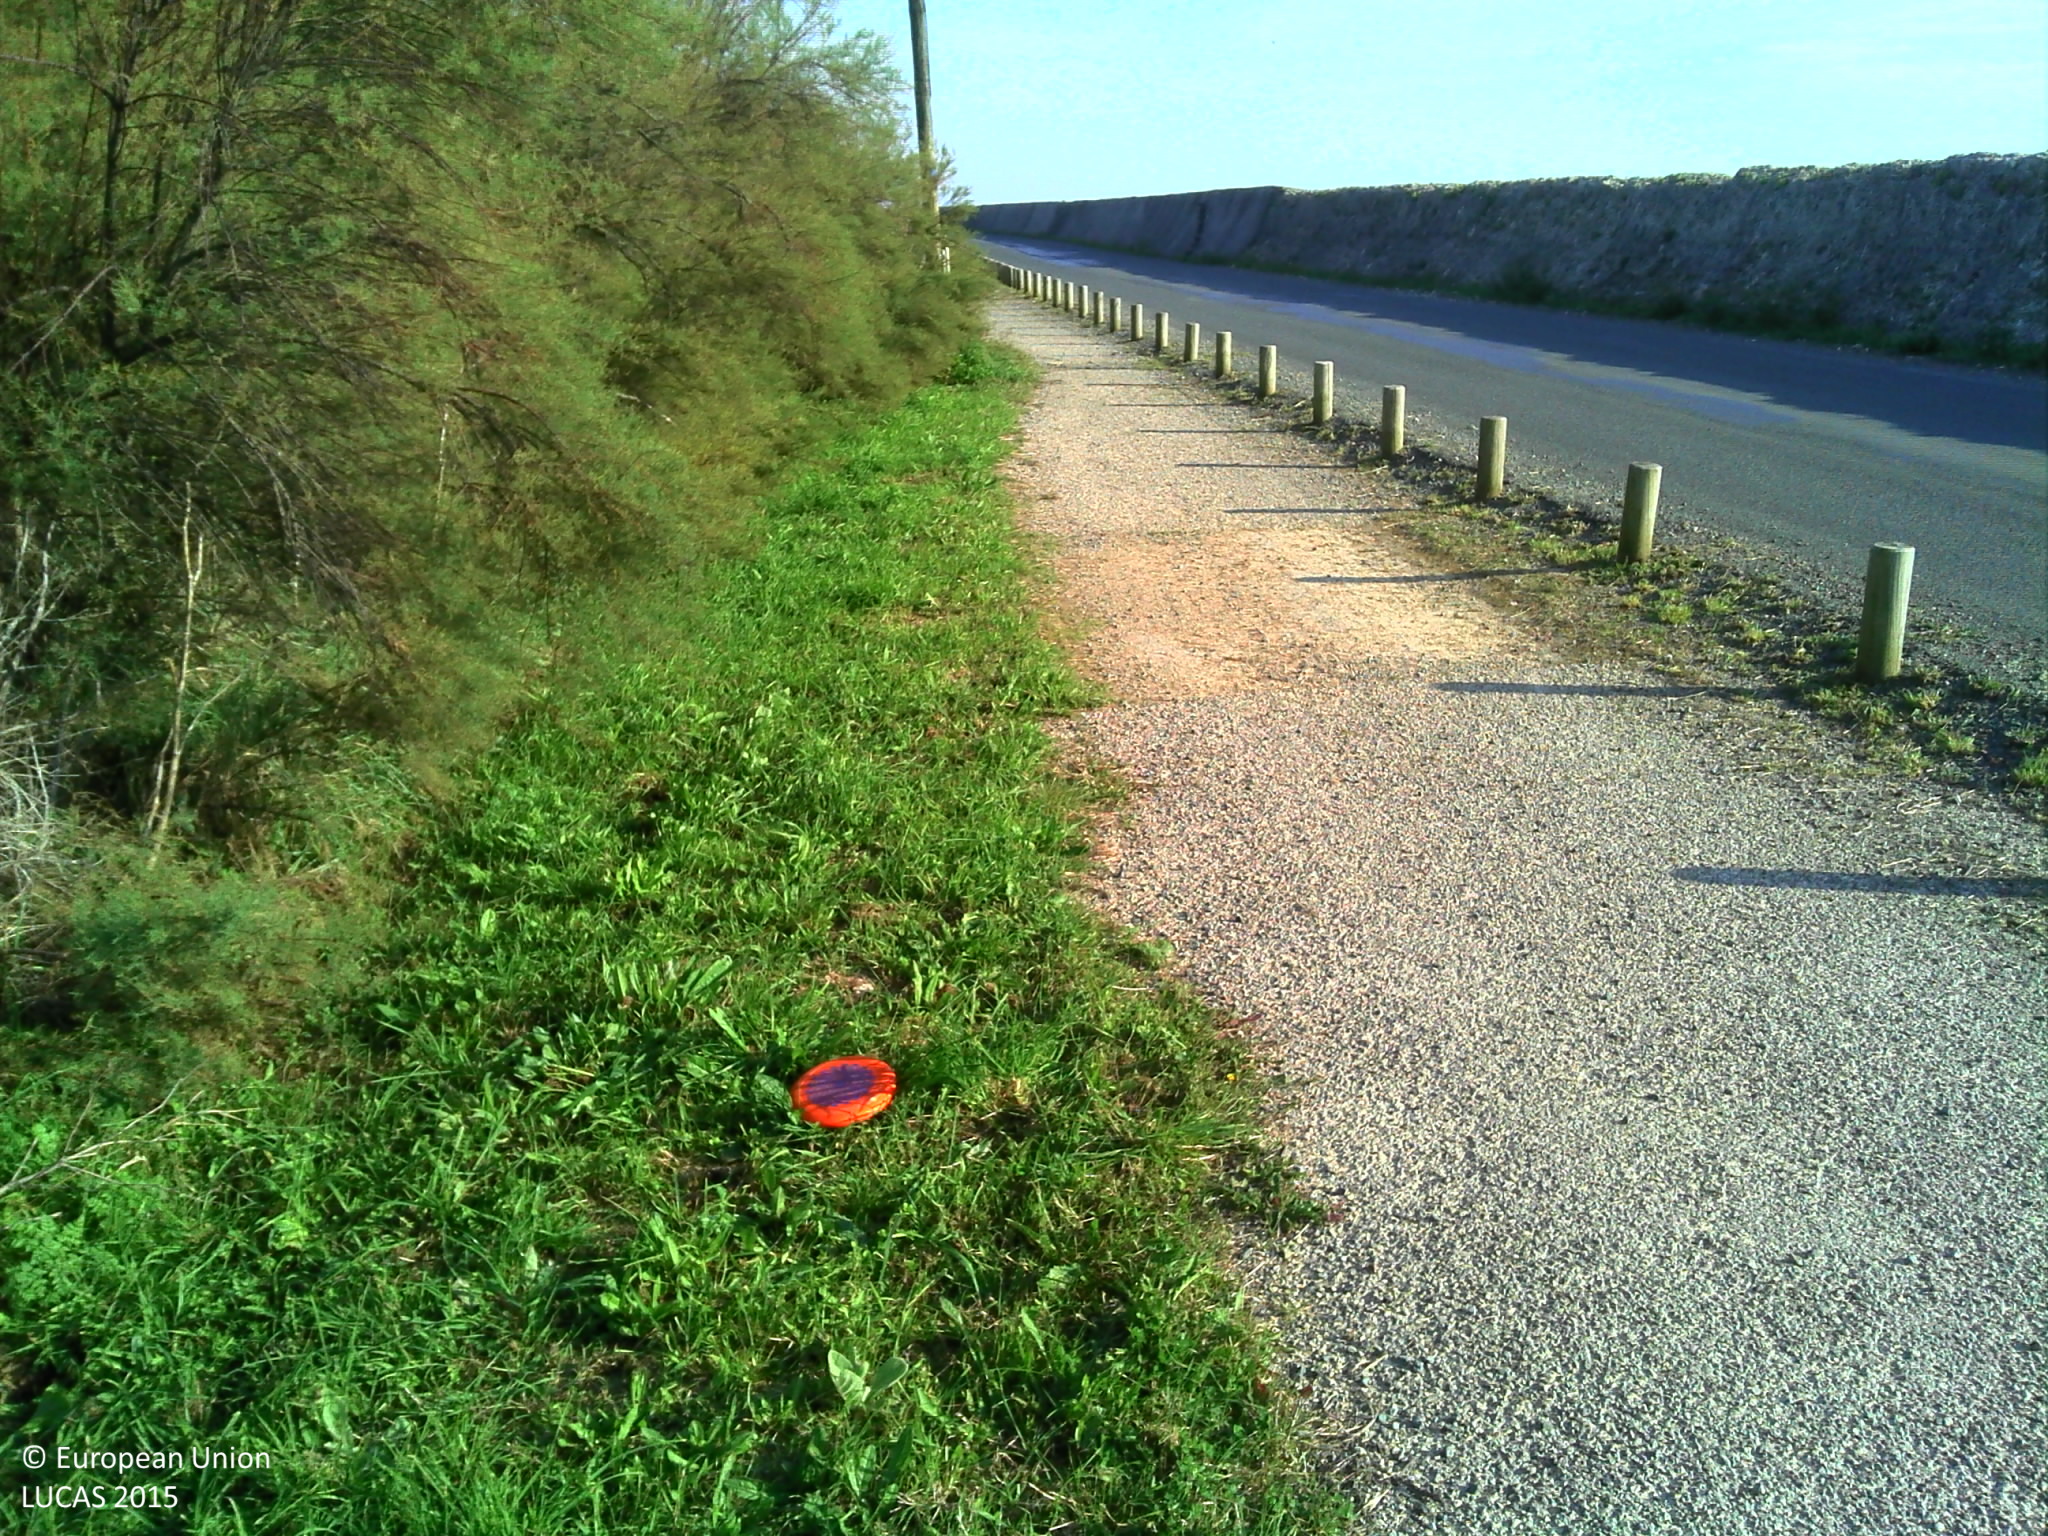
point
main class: Woodland
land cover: Other coniferous woodland
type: exotic forest
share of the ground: > 75 %
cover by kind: coniferous forest trees 85 %, herbaceous plants 15 %
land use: Road transport
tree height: < 5 m
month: October
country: FR
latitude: 46.2996
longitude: -1.2639
